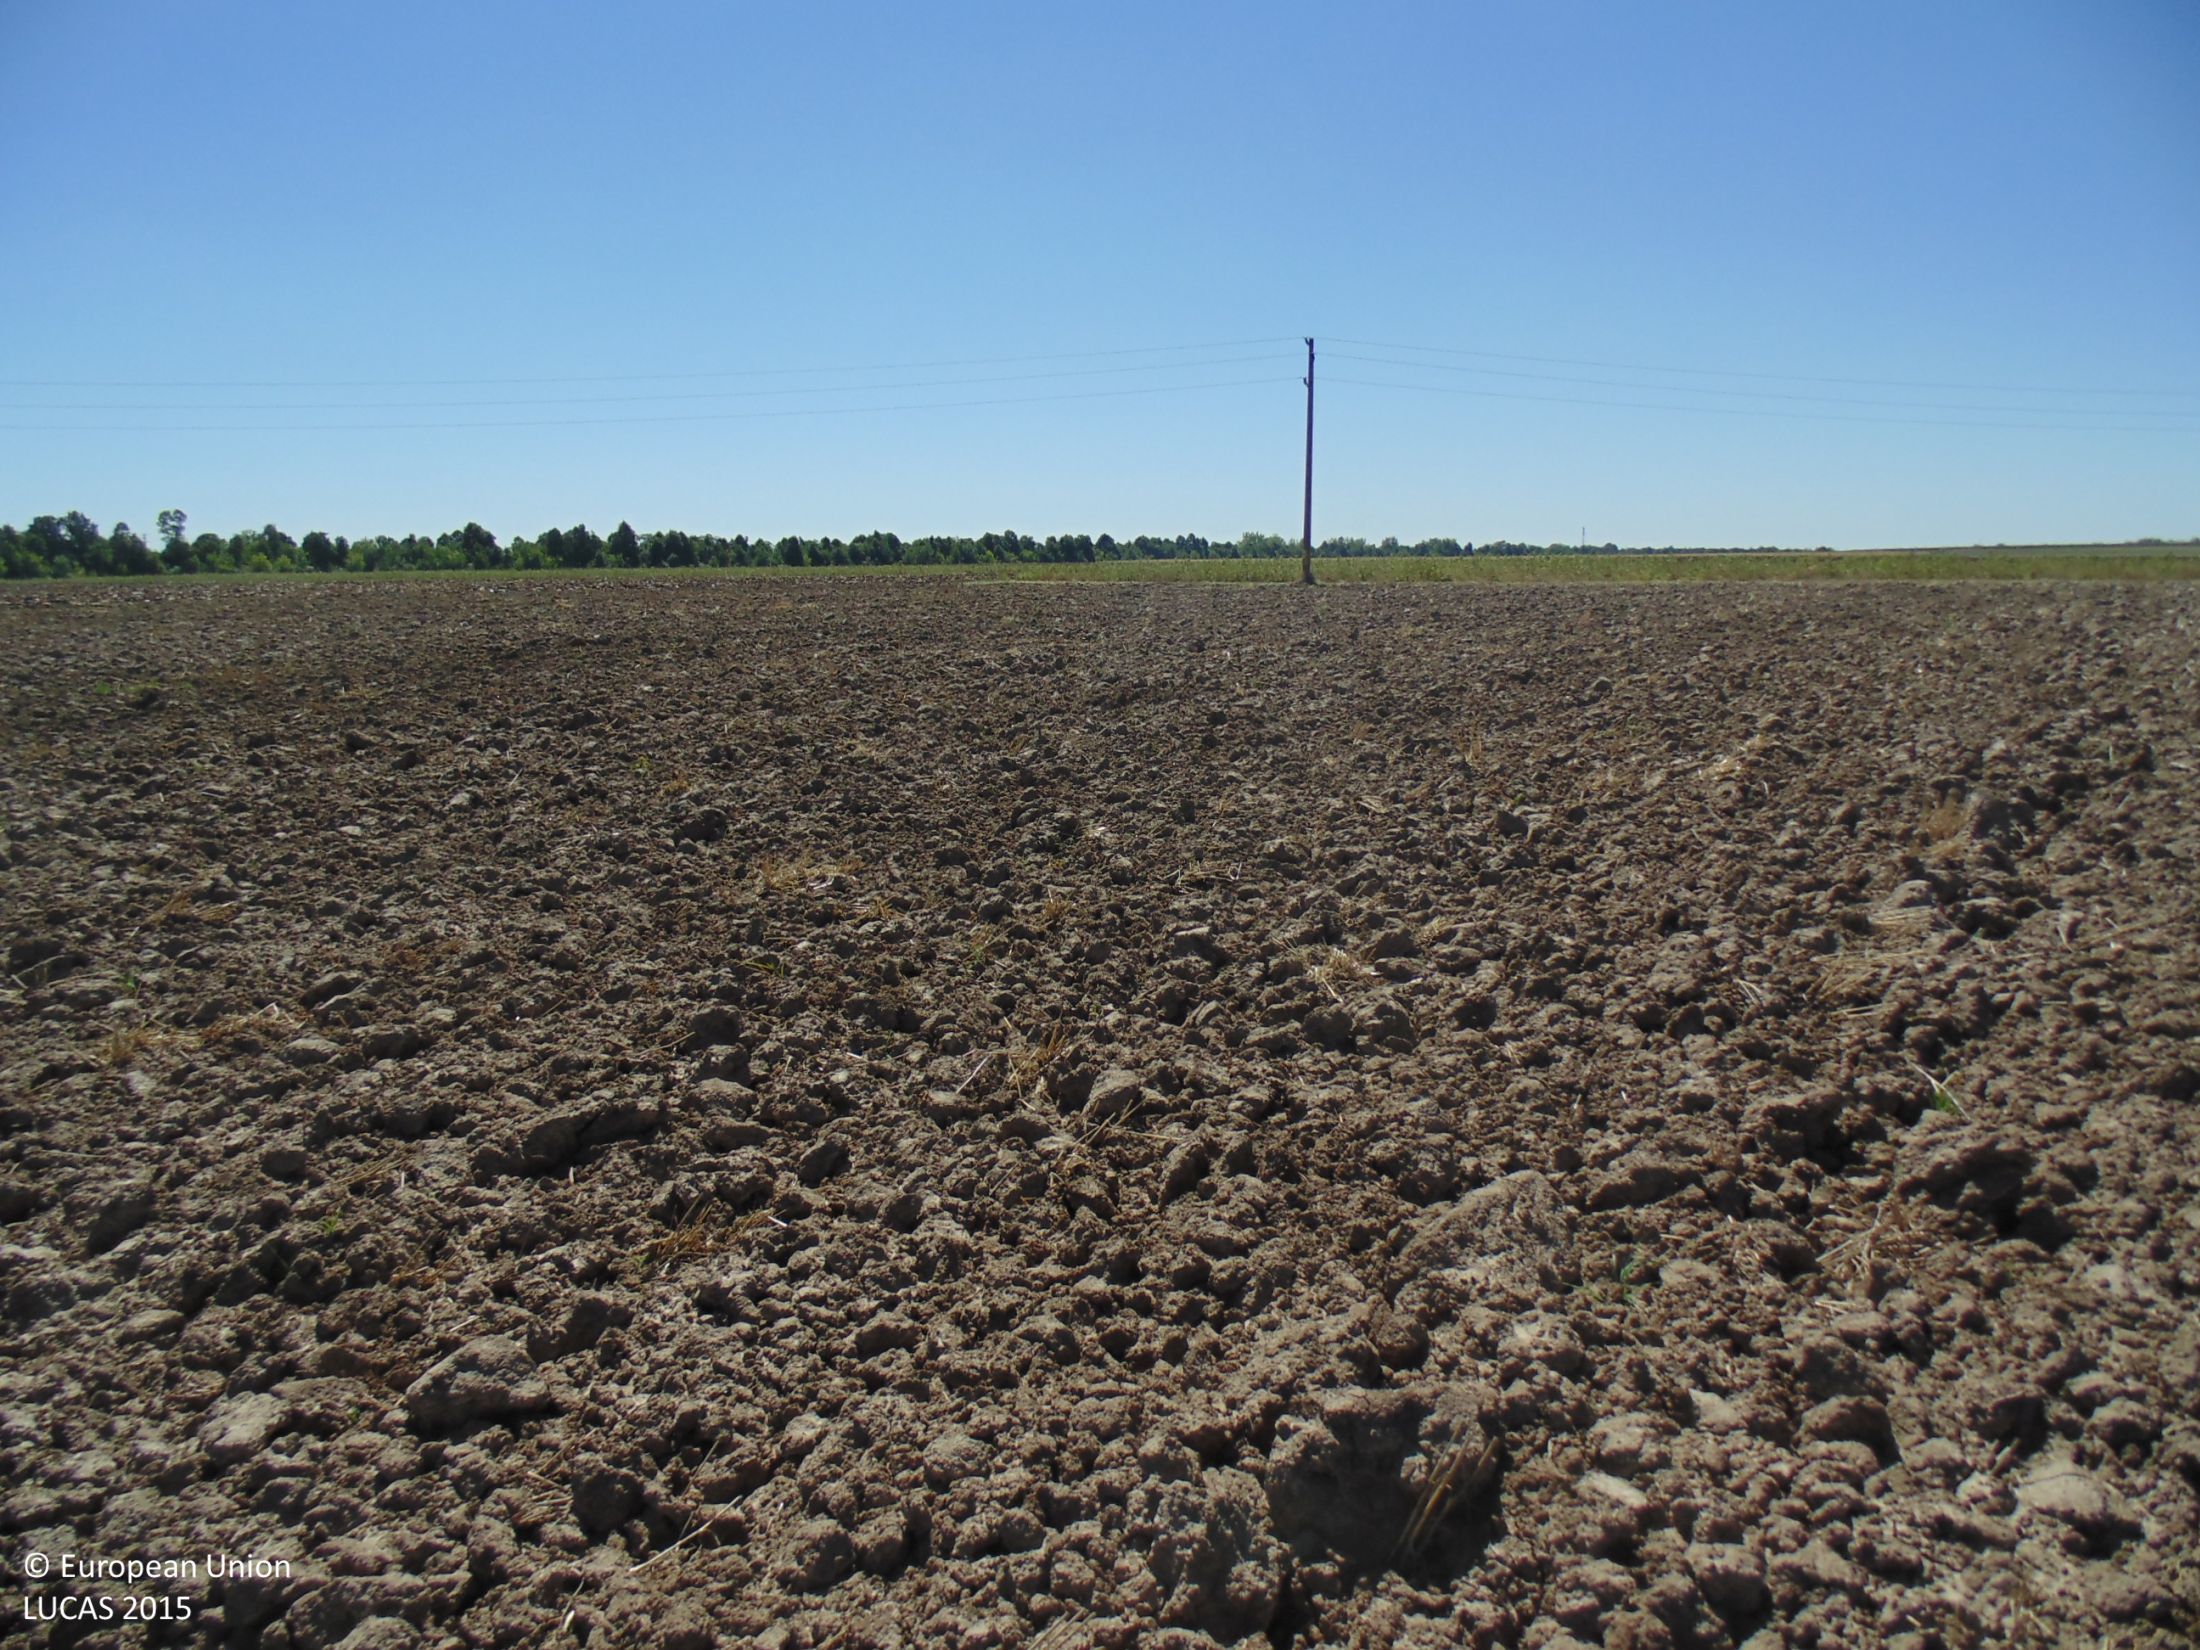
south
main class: Cropland
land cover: Common wheat
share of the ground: < 10 %
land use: Agriculture (excluding fallow land and kitchen gardens)
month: September
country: BG
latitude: 43.7952
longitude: 27.1389
